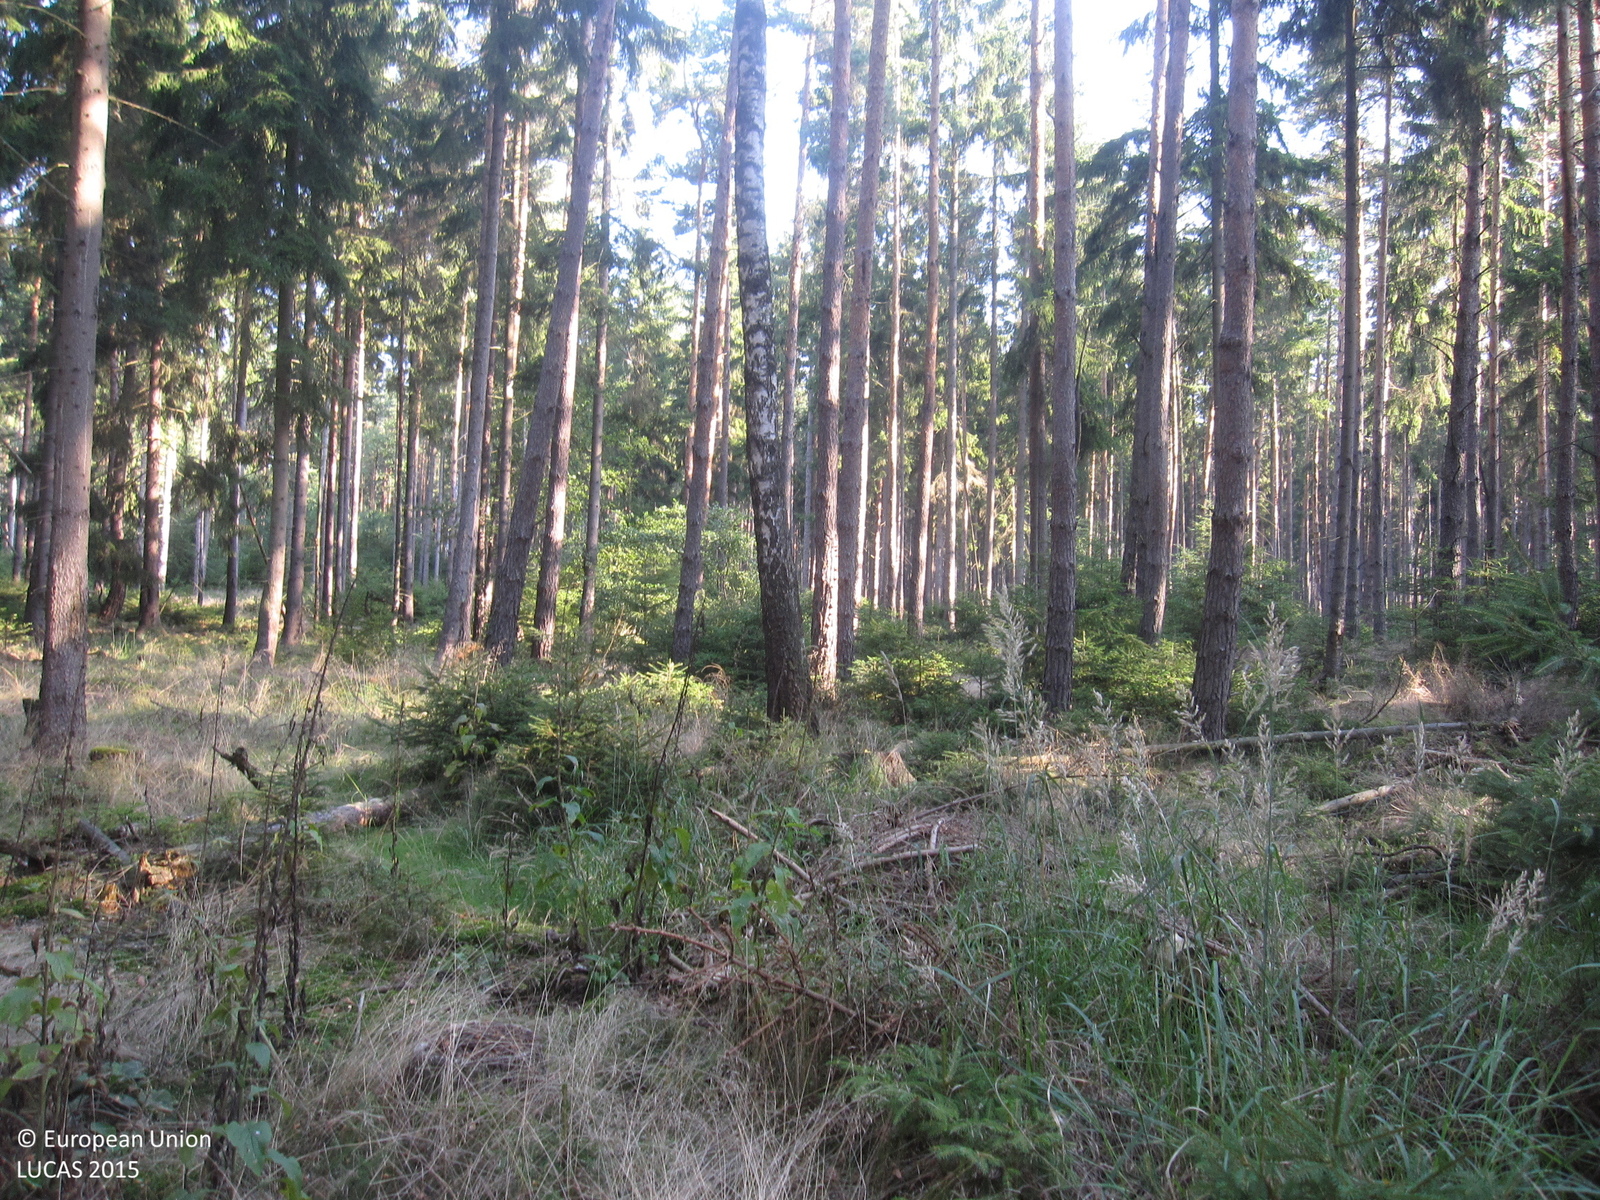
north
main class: Woodland
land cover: Spruce dominated coniferous woodland
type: hemiboreal forest and nemoral coniferous forest and mixed broadleaved-coniferous forest
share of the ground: > 75 %
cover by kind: coniferous forest trees 75 %, lichens and mosses 15 %, herbaceous plants 10 %
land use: Forestry
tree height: > 5 m
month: August
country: DE
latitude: 50.6335
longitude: 12.0497
